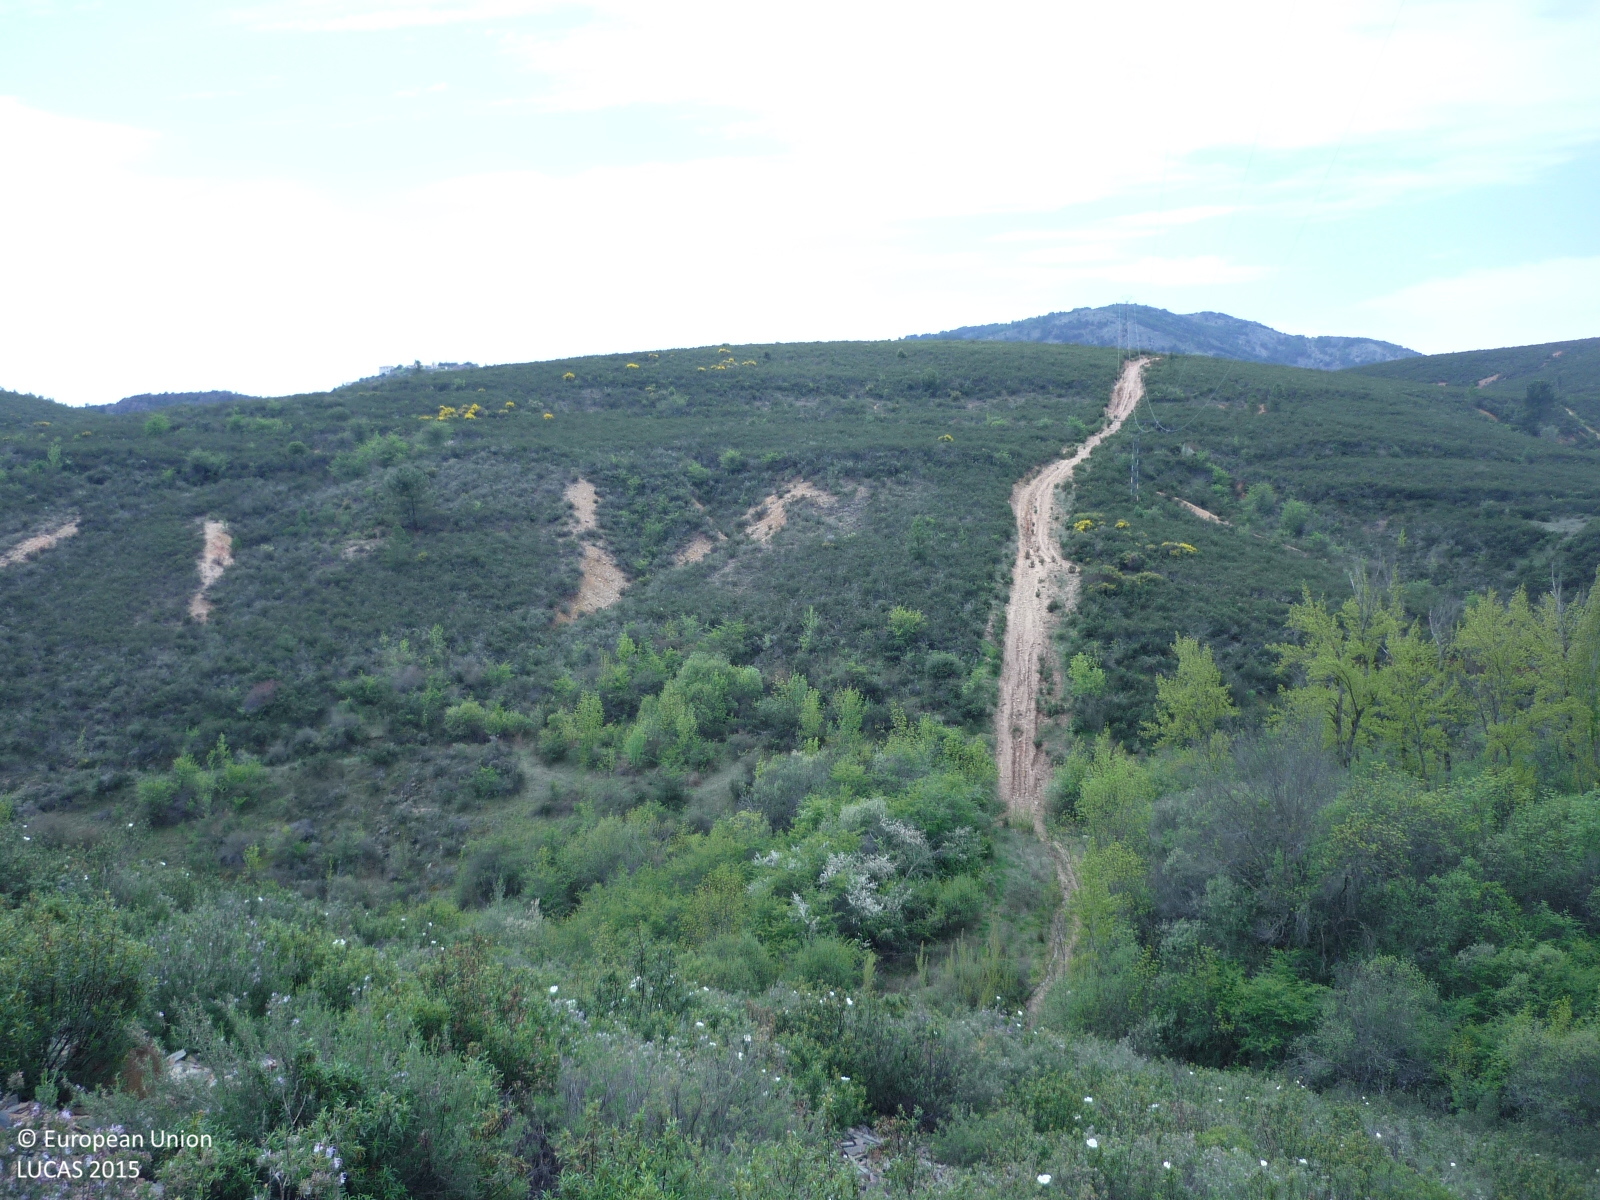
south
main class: Shrubland
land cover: Shrubland without tree cover
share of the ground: > 75 %
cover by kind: shrubs 65 %, unconsolidated bare surface 20 %, herbaceous plants 15 %
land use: Semi-natural and natural areas not in use
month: April
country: ES
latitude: 40.9263
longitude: -3.4718
